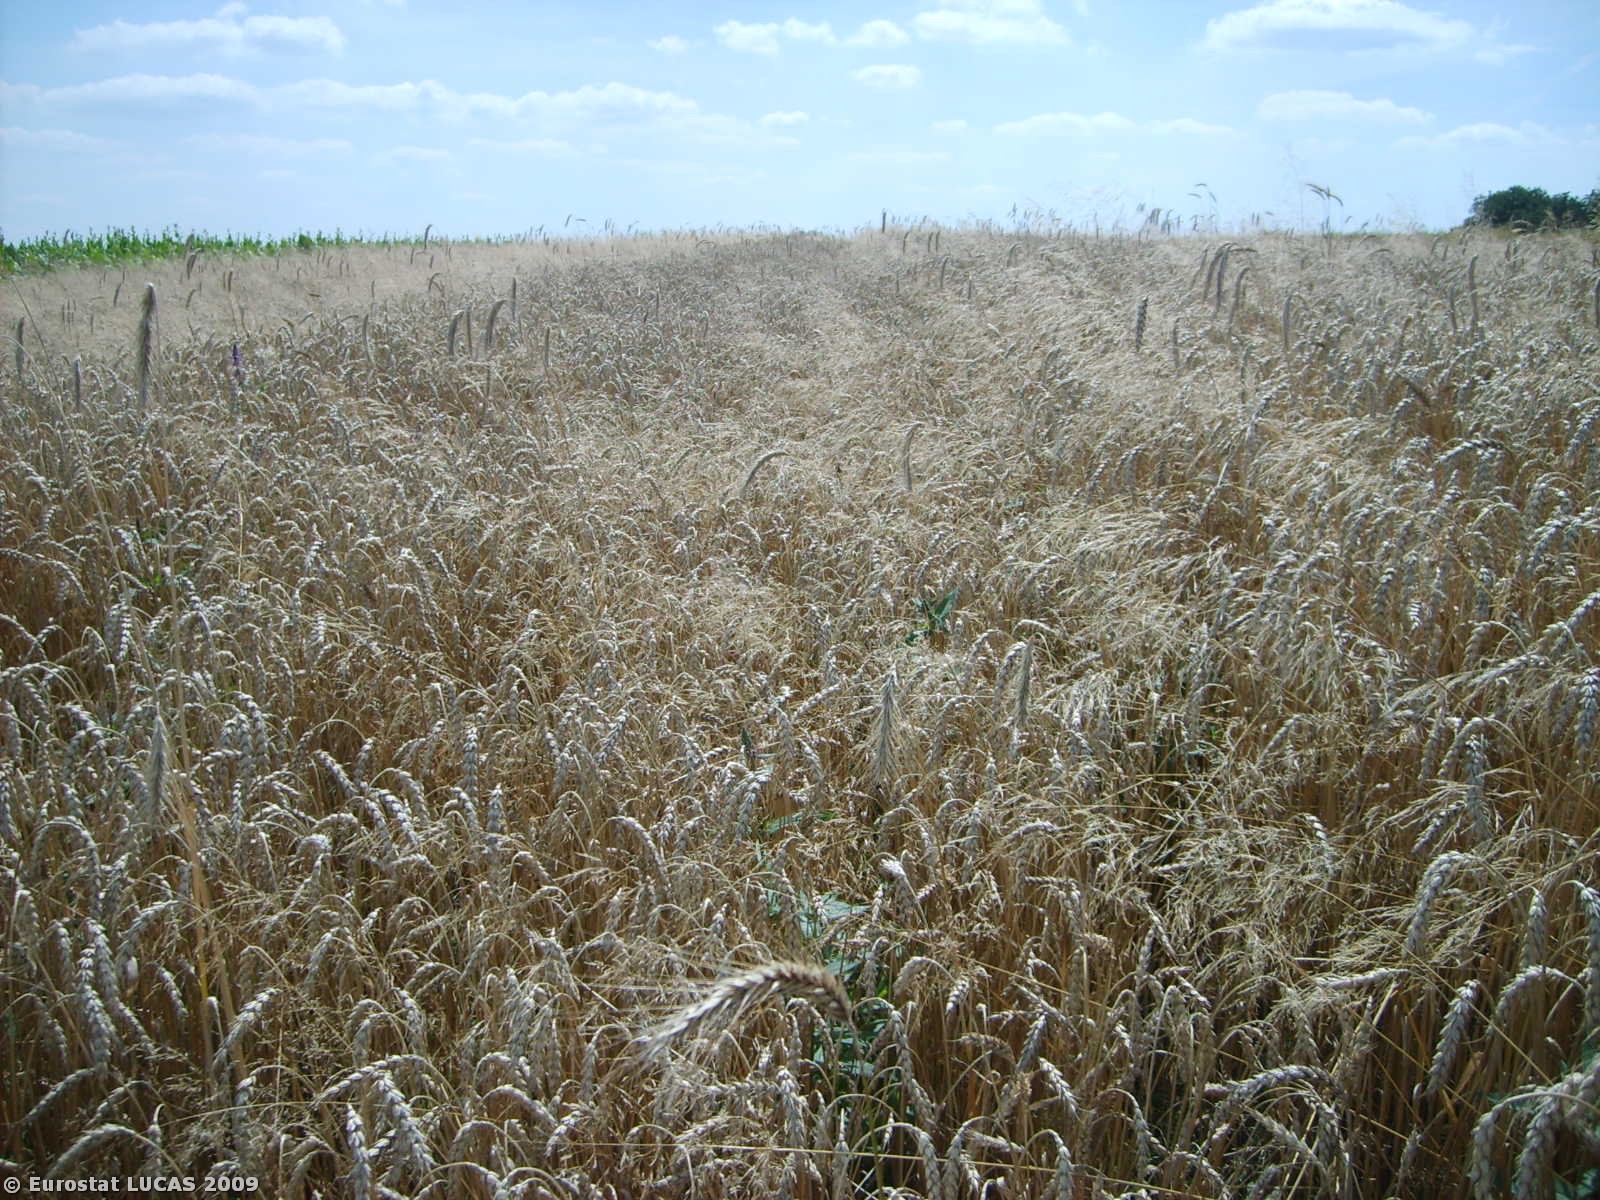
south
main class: Cropland
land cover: Common wheat
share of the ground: > 75 %
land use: Agriculture (excluding fallow land and kitchen gardens)
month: July
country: PL
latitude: 50.2182
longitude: 20.3652
